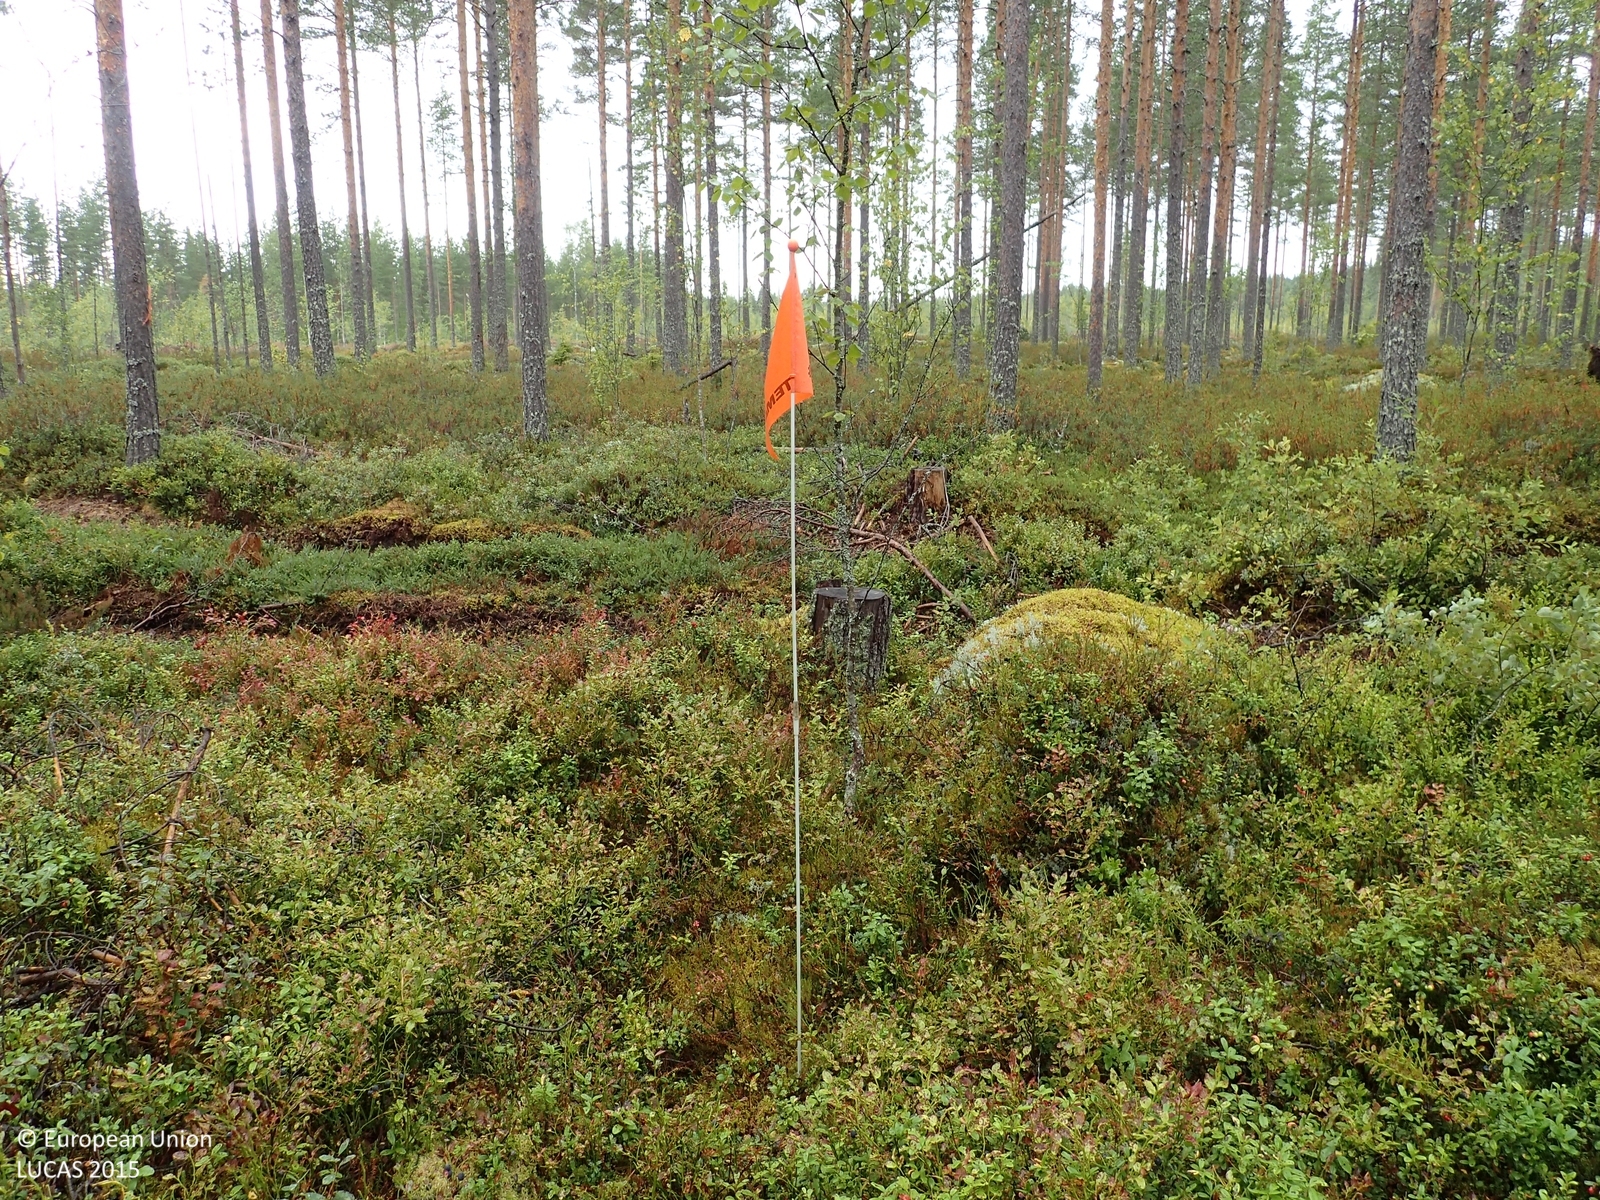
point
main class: Woodland
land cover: Pine dominated coniferous woodland
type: boreal forest
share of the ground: 50 - 75 %
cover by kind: coniferous forest trees 60 %, shrubs 25 %, lichens and mosses 10 %, broadleaved forest trees 5 %
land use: Forestry
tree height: > 5 m
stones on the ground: < 10 %
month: August
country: FI
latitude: 62.6692
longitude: 23.2039
